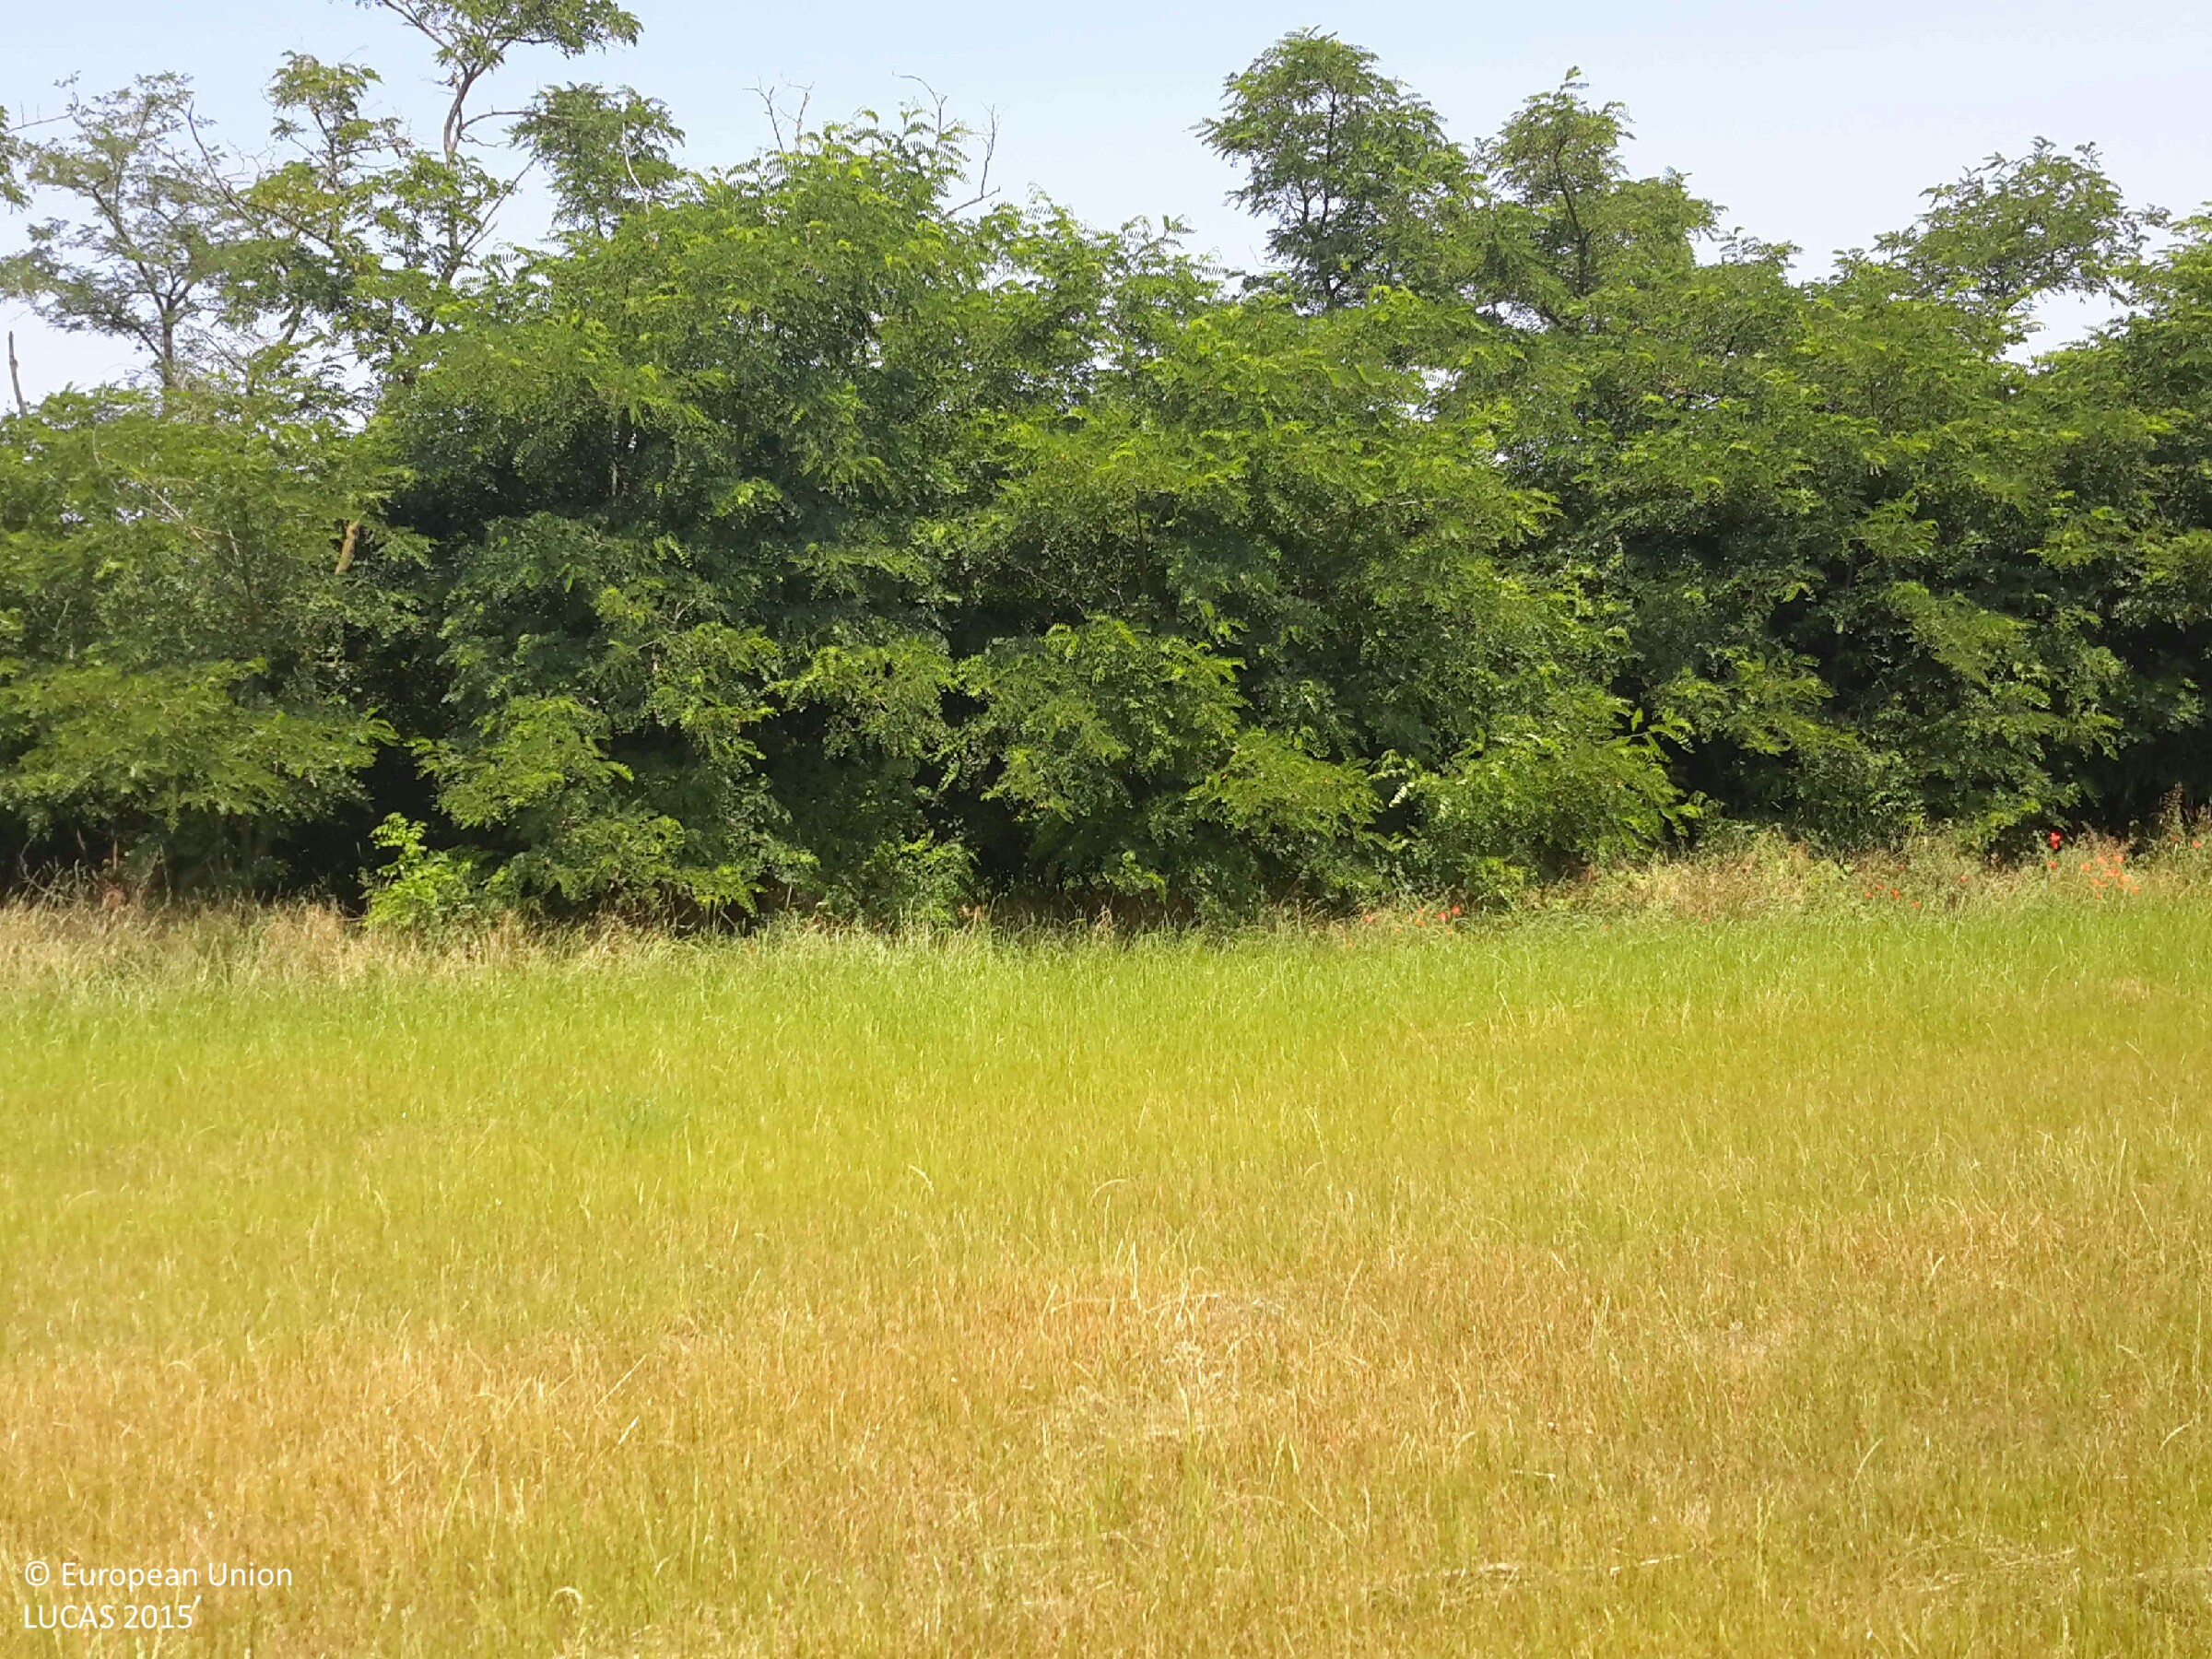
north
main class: Grassland
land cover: Grassland without tree/shrub cover
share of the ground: > 75 %
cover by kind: herbaceous plants 100 %
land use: Agriculture (excluding fallow land and kitchen gardens)
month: July
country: HU
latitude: 47.3113
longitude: 17.3217
